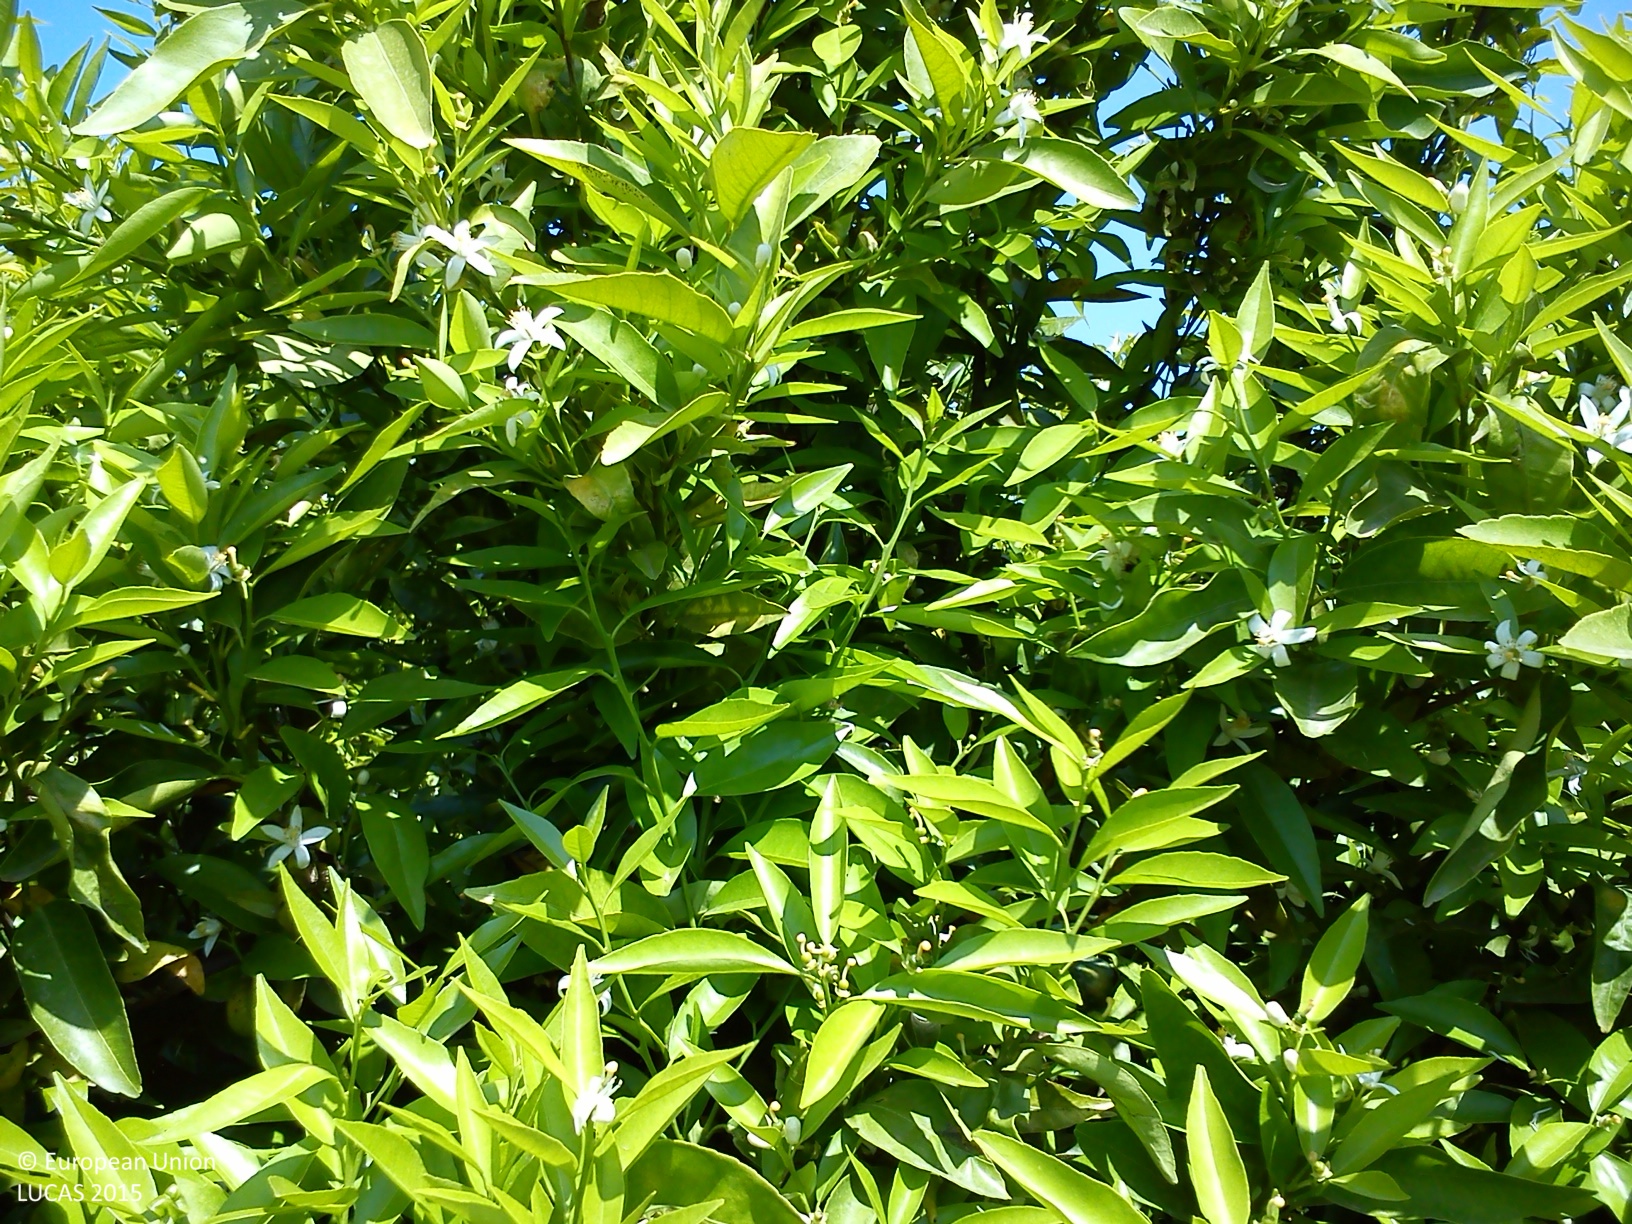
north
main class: Cropland
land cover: Oranges
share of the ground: 50 - 75 %
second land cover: Other bare soil
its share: > 75 %
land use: Agriculture (excluding fallow land and kitchen gardens)
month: April
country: ES
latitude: 39.6096
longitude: -0.6808
